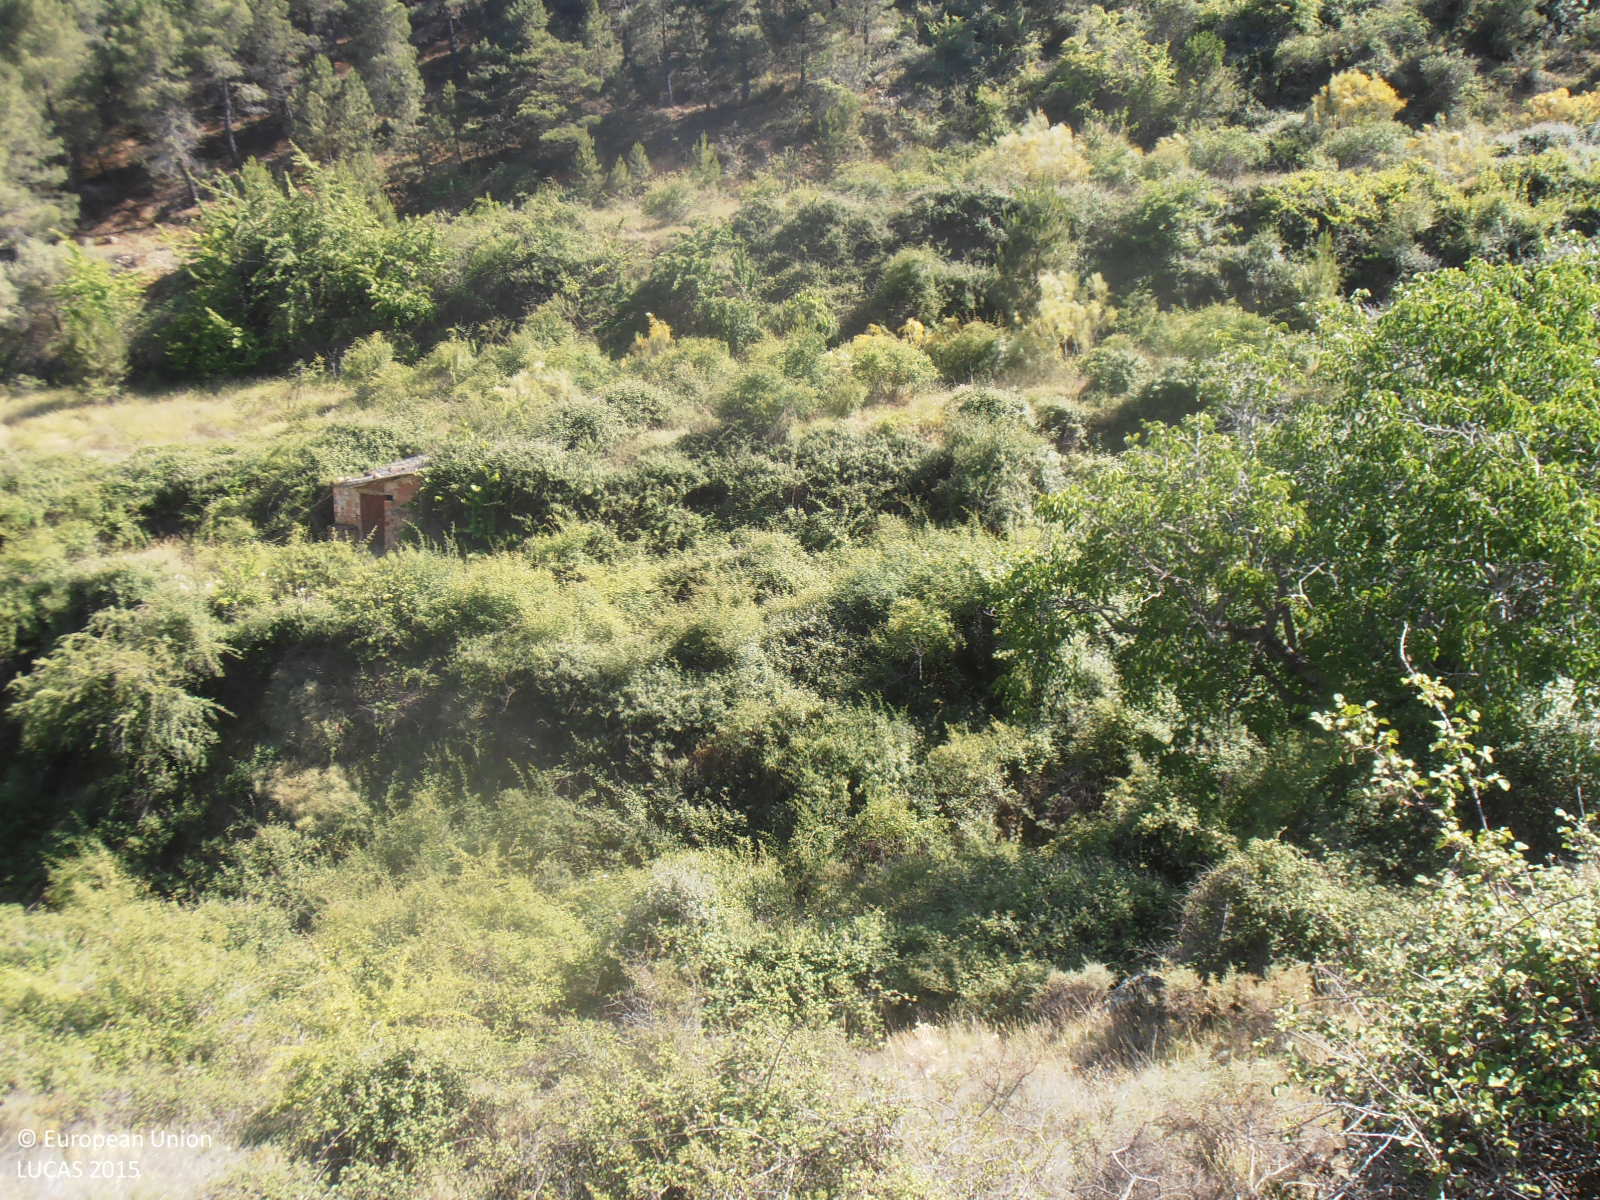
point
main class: Shrubland
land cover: Shrubland without tree cover
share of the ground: > 75 %
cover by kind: shrubs 100 %
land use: Abandoned areas
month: June
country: ES
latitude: 41.3326
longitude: -1.4102
